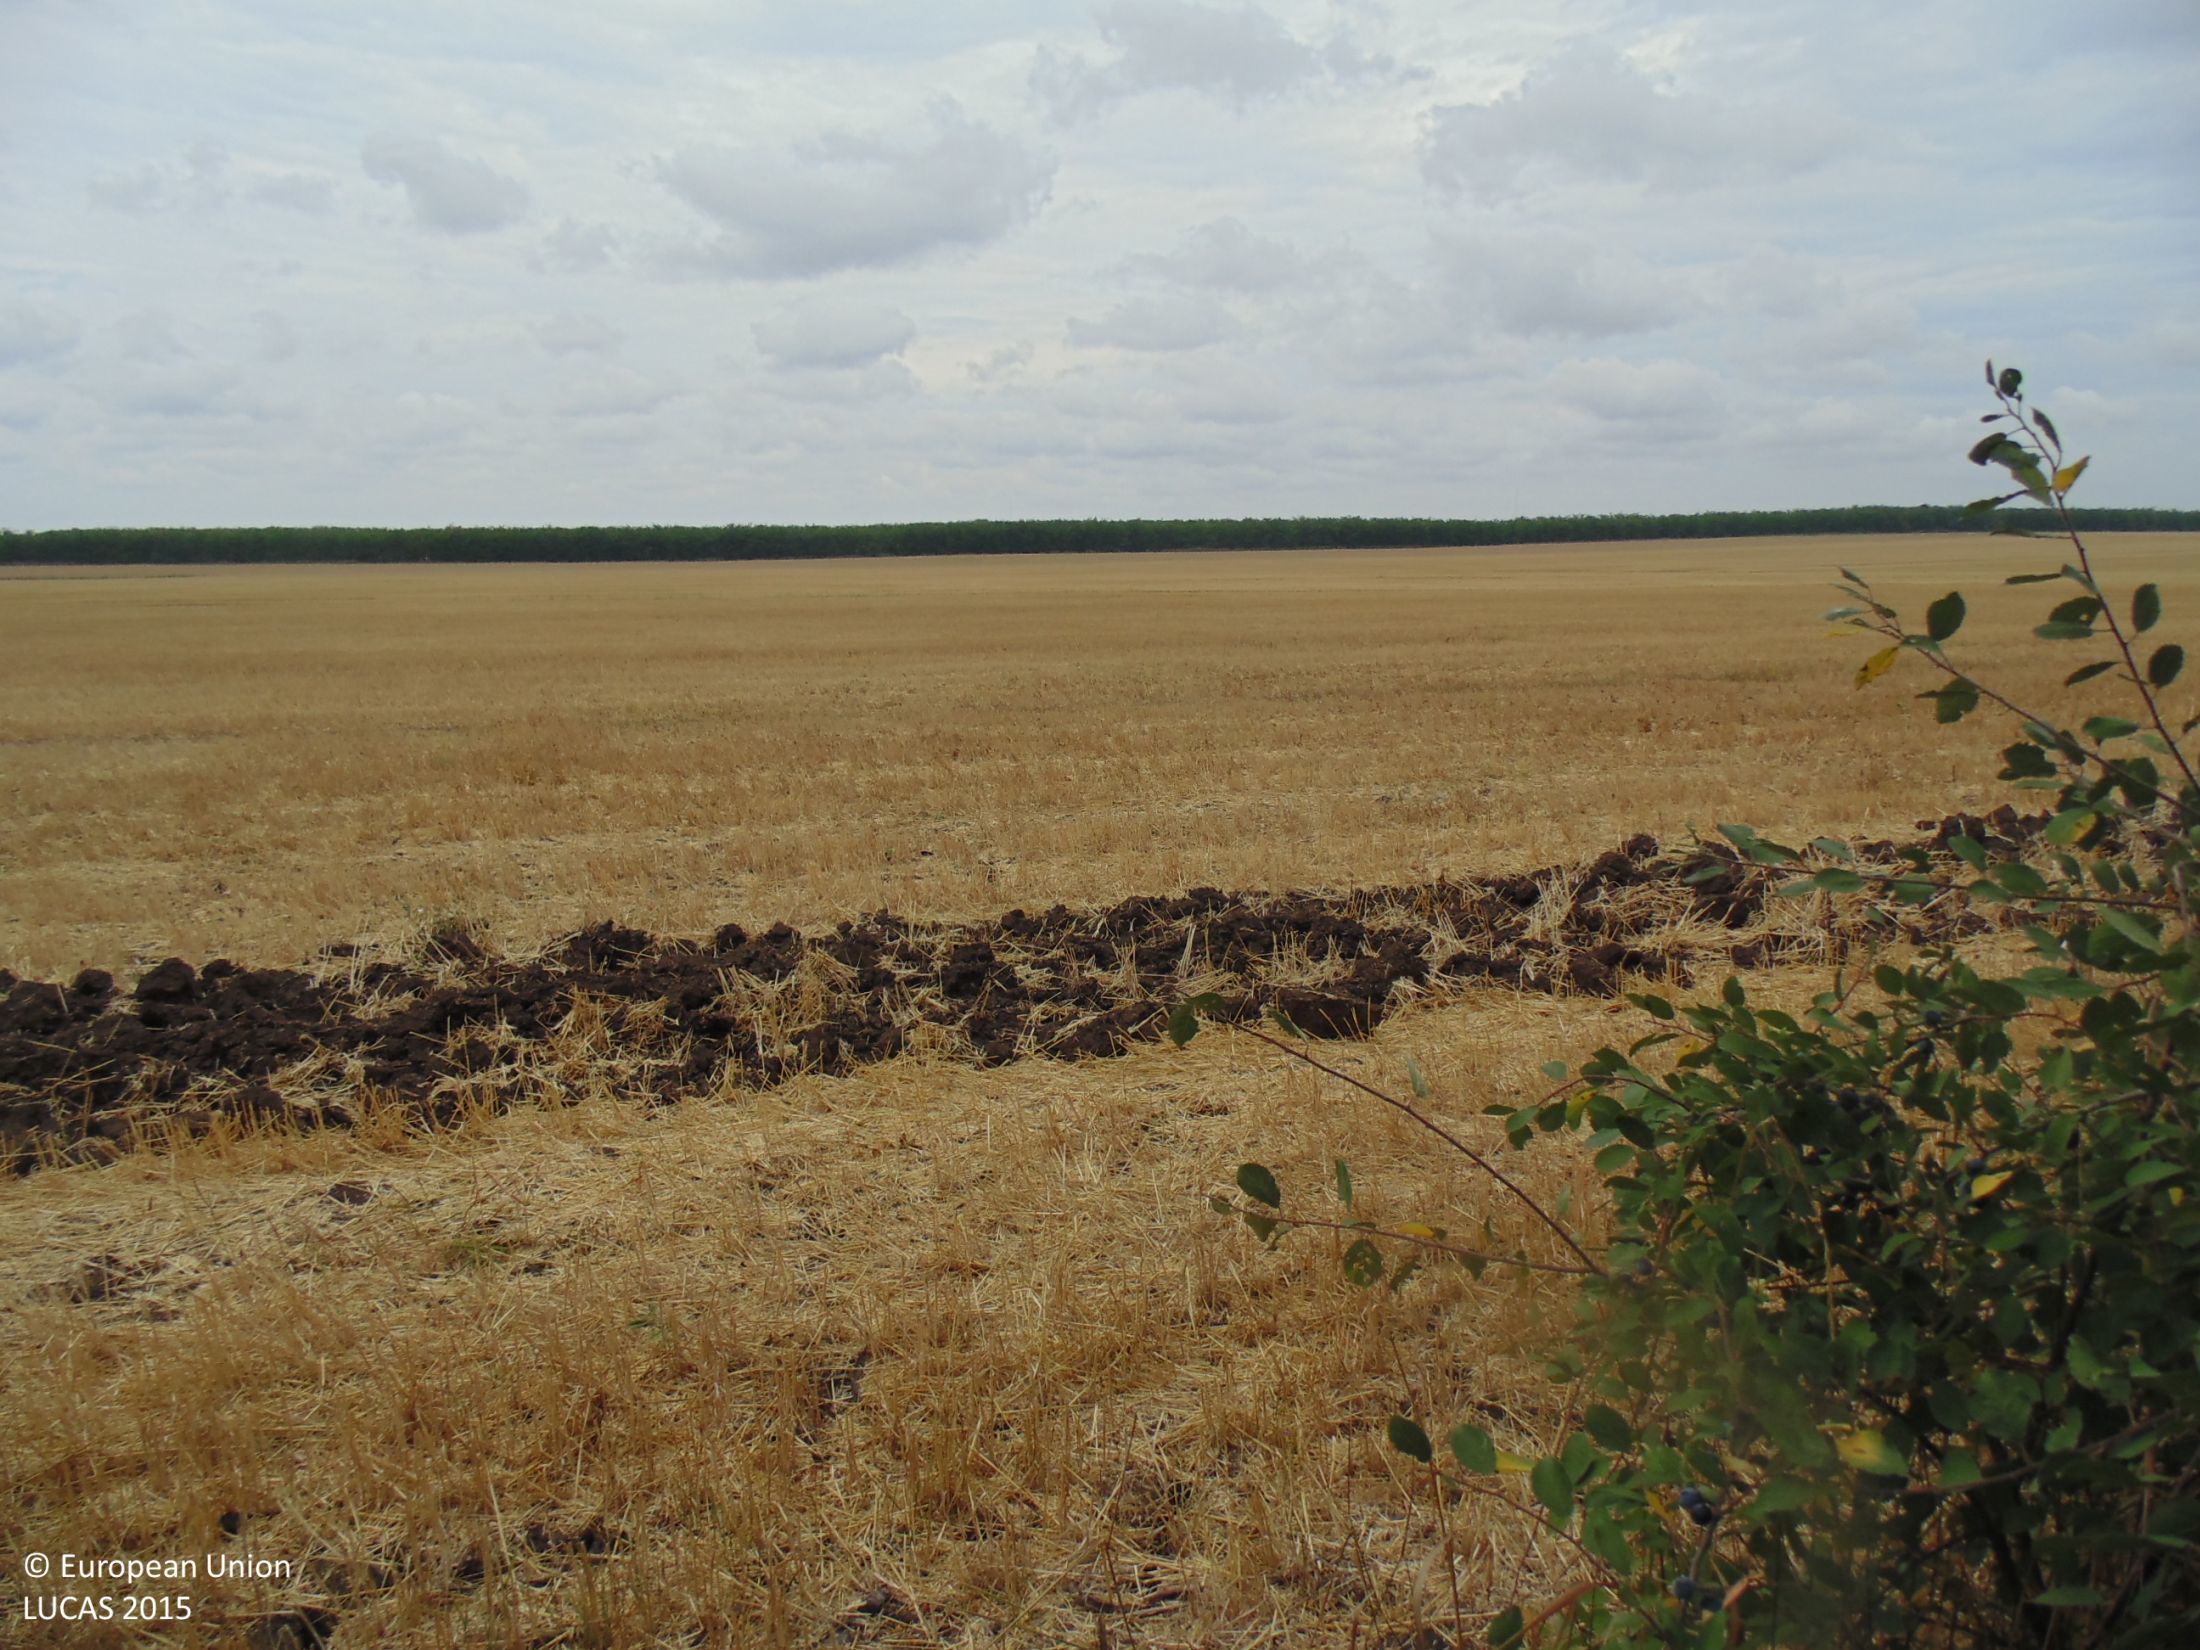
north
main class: Woodland
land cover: Broadleaved woodland
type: mesophytic deciduous forest
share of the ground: > 75 %
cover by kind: broadleaved forest trees 90 %, shrubs 10 %
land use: Forestry
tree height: > 5 m
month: August
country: BG
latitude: 43.5784
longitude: 28.4765
